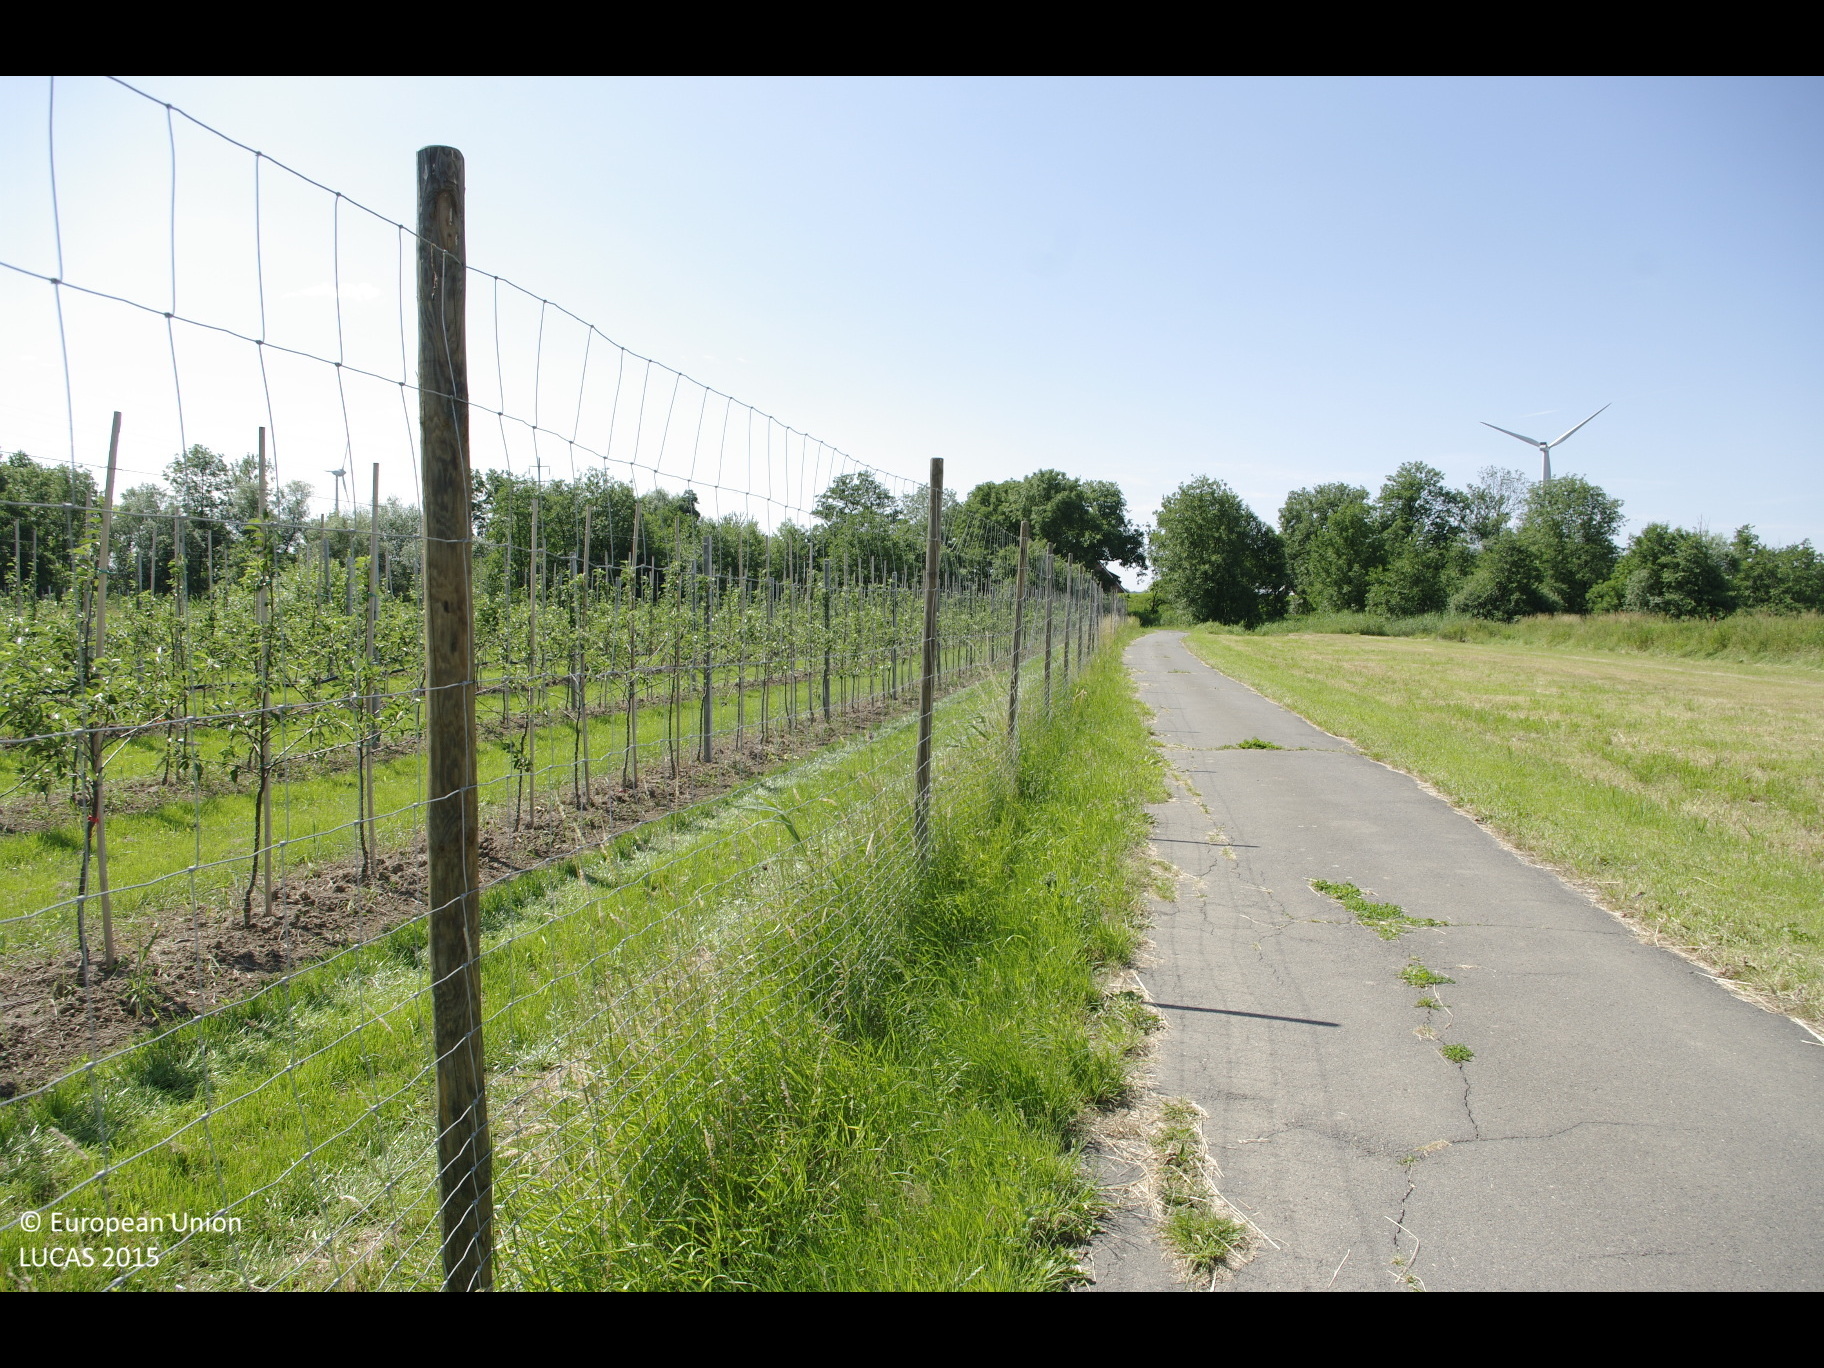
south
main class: Grassland
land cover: Grassland without tree/shrub cover
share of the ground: > 75 %
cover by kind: herbaceous plants 100 %
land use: Agriculture (excluding fallow land and kitchen gardens)
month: July
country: DE
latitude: 53.5097
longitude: 9.8644
